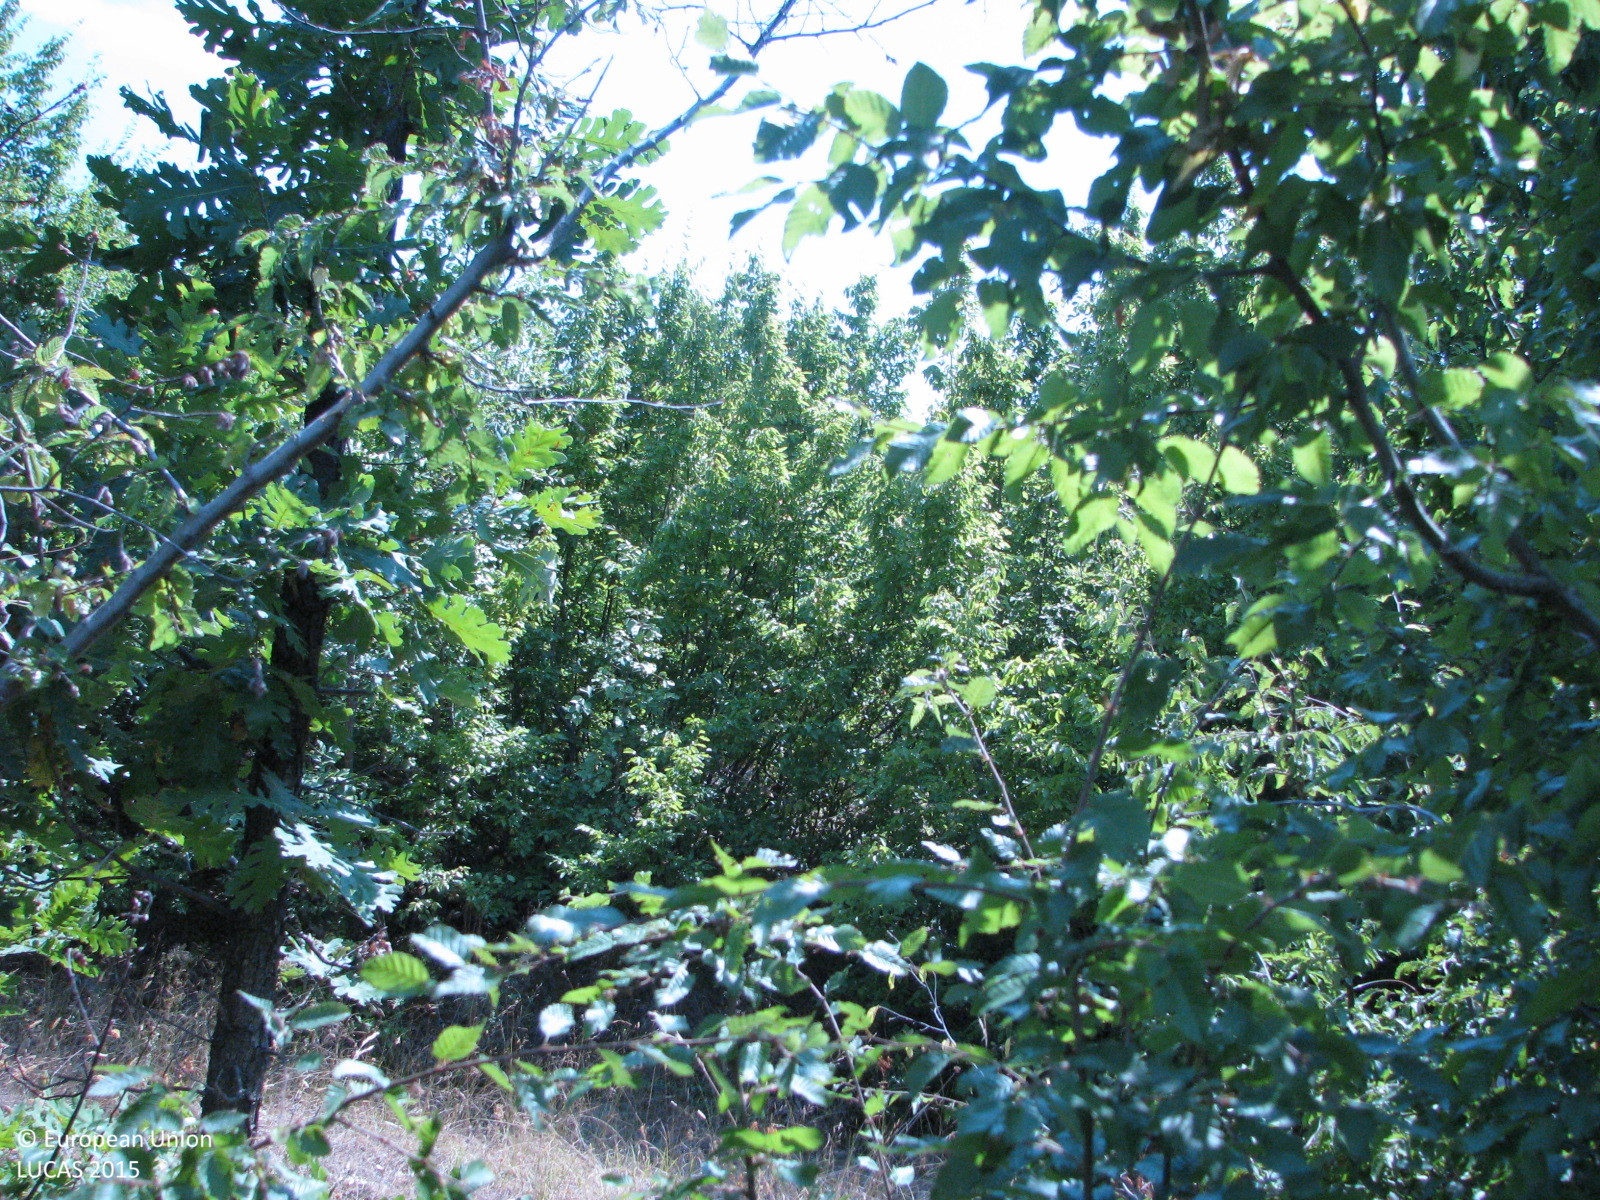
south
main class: Woodland
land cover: Broadleaved woodland
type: hemiboreal forest and nemoral coniferous forest and mixed broadleaved-coniferous forest
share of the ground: 50 - 75 %
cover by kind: broadleaved forest trees 40 %, herbaceous plants 30 %, shrubs 20 %, coniferous forest trees 10 %
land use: Forestry
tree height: > 5 m
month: July
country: BG
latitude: 42.6818
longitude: 26.0843
